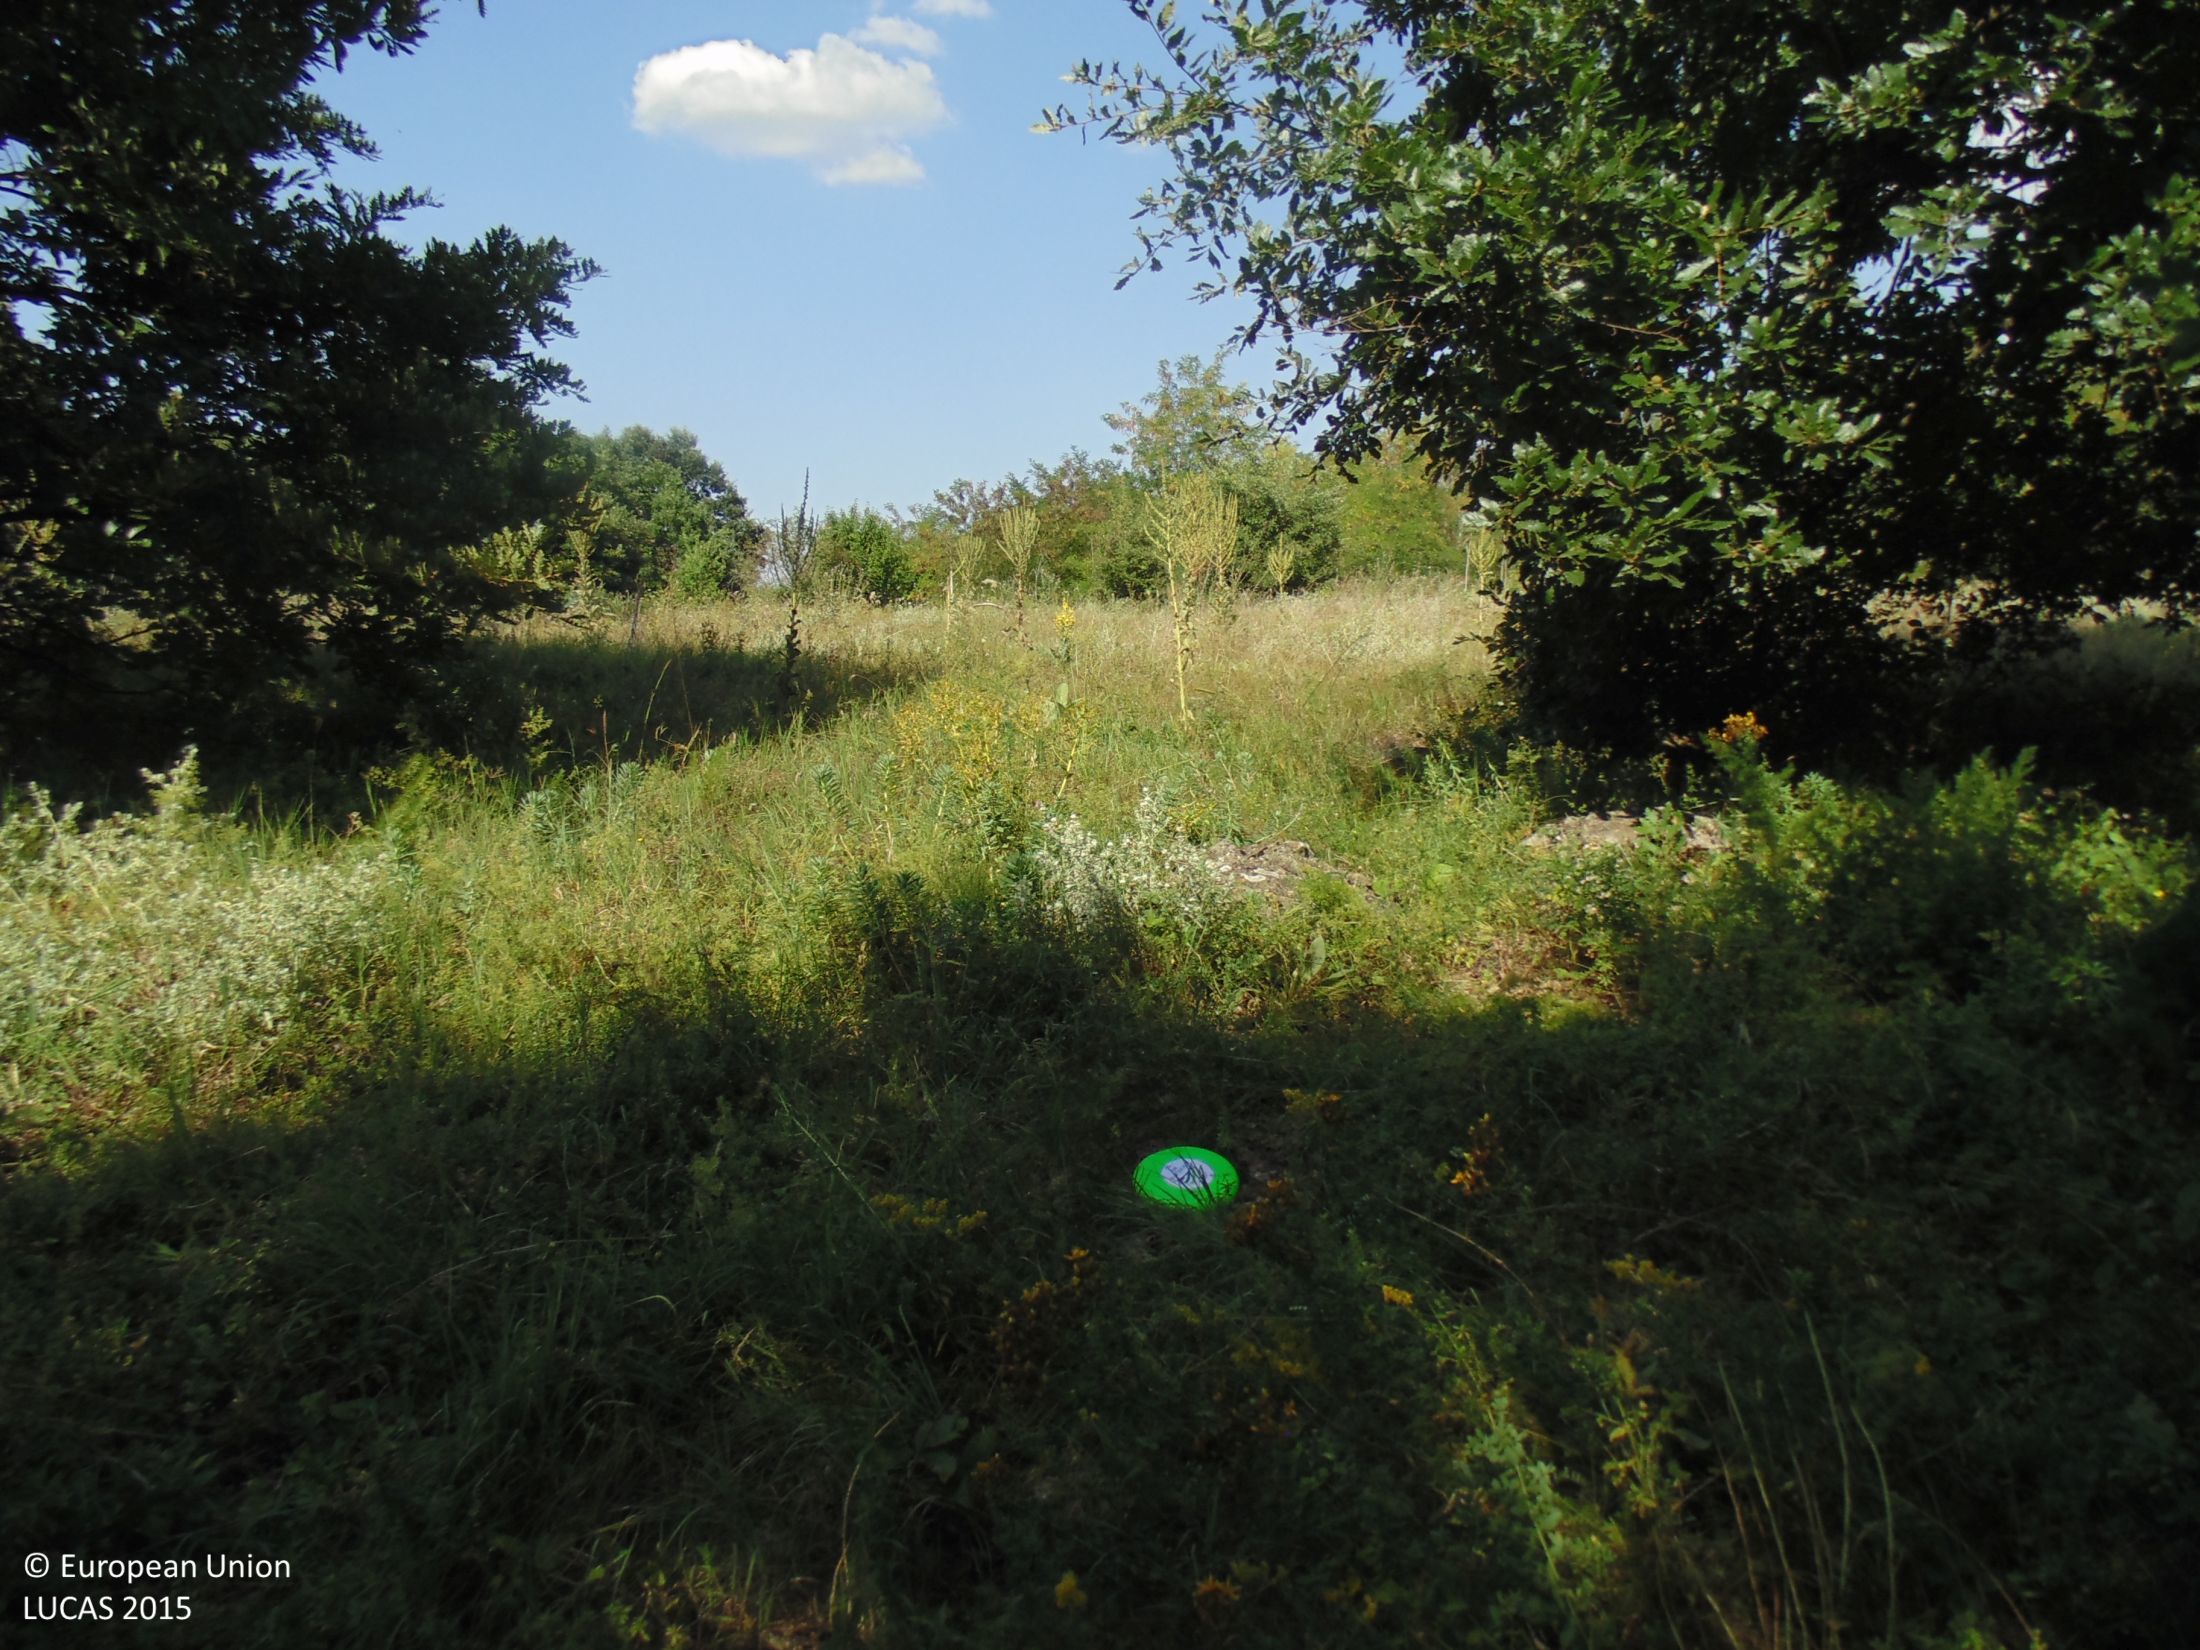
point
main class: Woodland
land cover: Broadleaved woodland
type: mesophytic deciduous forest
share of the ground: > 75 %
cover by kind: broadleaved forest trees 75 %, herbaceous plants 20 %, shrubs 5 %
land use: Forestry
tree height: > 5 m
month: July
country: BG
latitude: 43.5980
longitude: 27.5378
